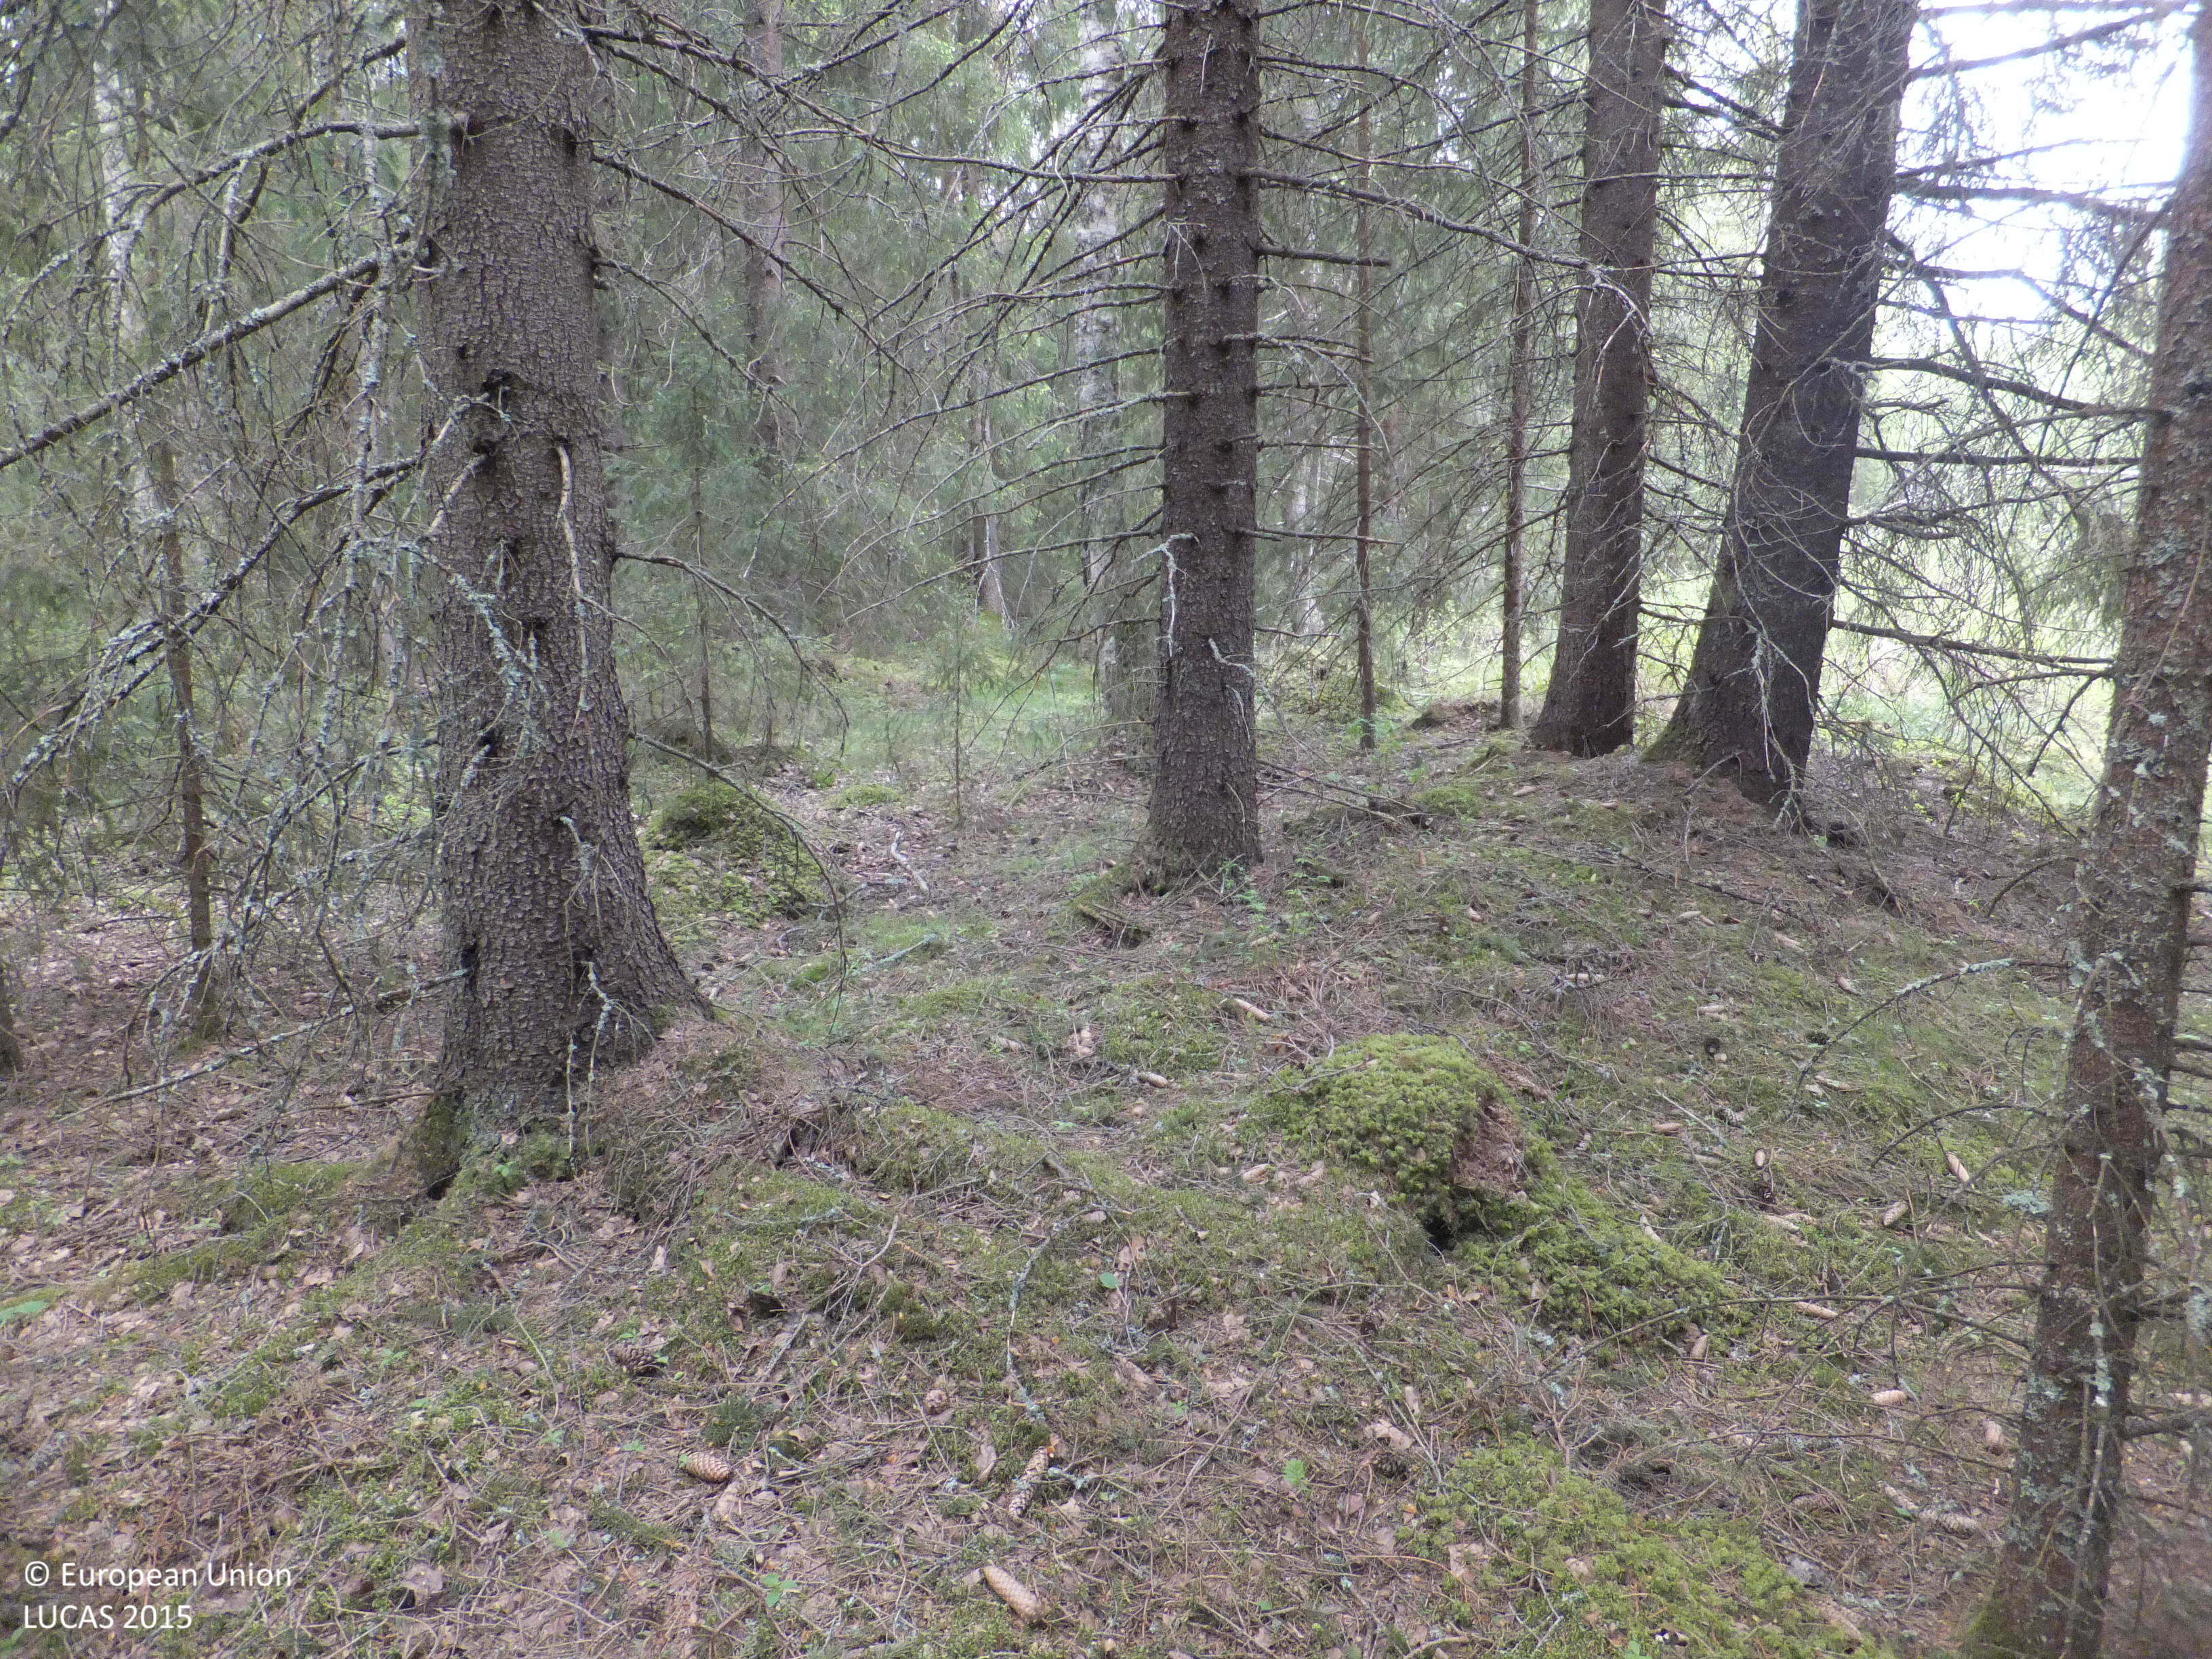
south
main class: Woodland
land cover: Spruce dominated mixed woodland
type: boreal forest
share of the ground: 50 - 75 %
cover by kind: coniferous forest trees 40 %, broadleaved forest trees 30 %, shrubs 10 %, herbaceous plants 10 %, lichens and mosses 10 %
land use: Forestry
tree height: > 5 m
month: June
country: FI
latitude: 63.4776
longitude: 22.7566
